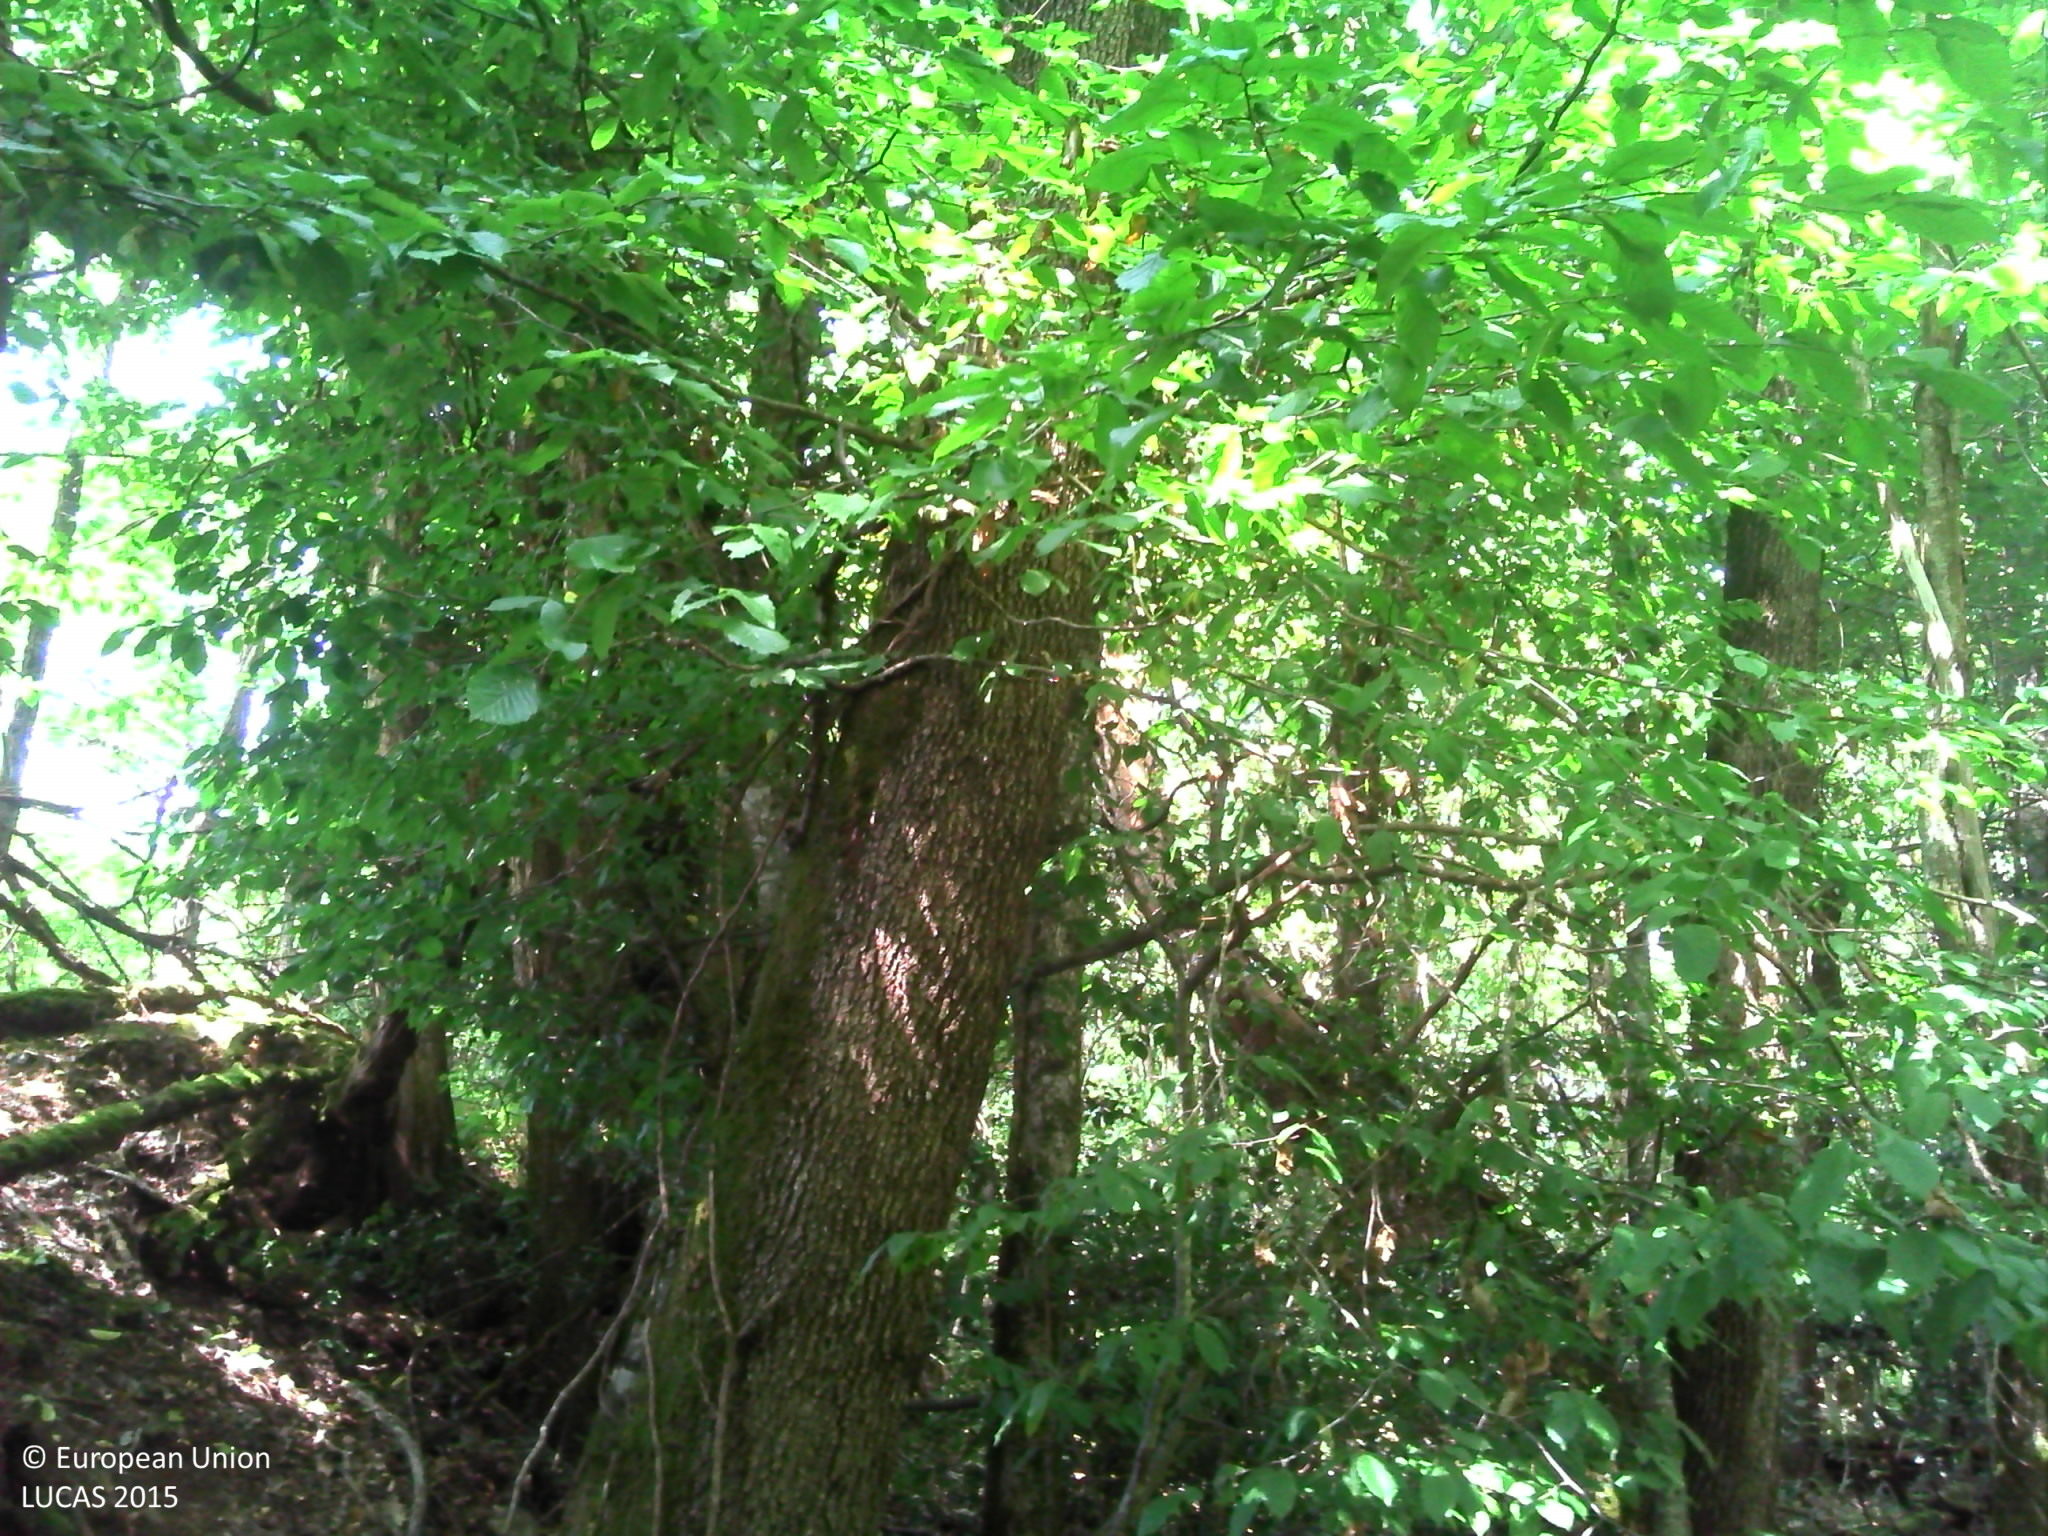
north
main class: Woodland
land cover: Broadleaved woodland
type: mesophytic deciduous forest
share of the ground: > 75 %
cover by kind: broadleaved forest trees 70 %, herbaceous plants 15 %, shrubs 10 %
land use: Forestry
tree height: > 5 m
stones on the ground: < 10 %
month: August
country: FR
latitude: 45.2072
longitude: 0.7597
